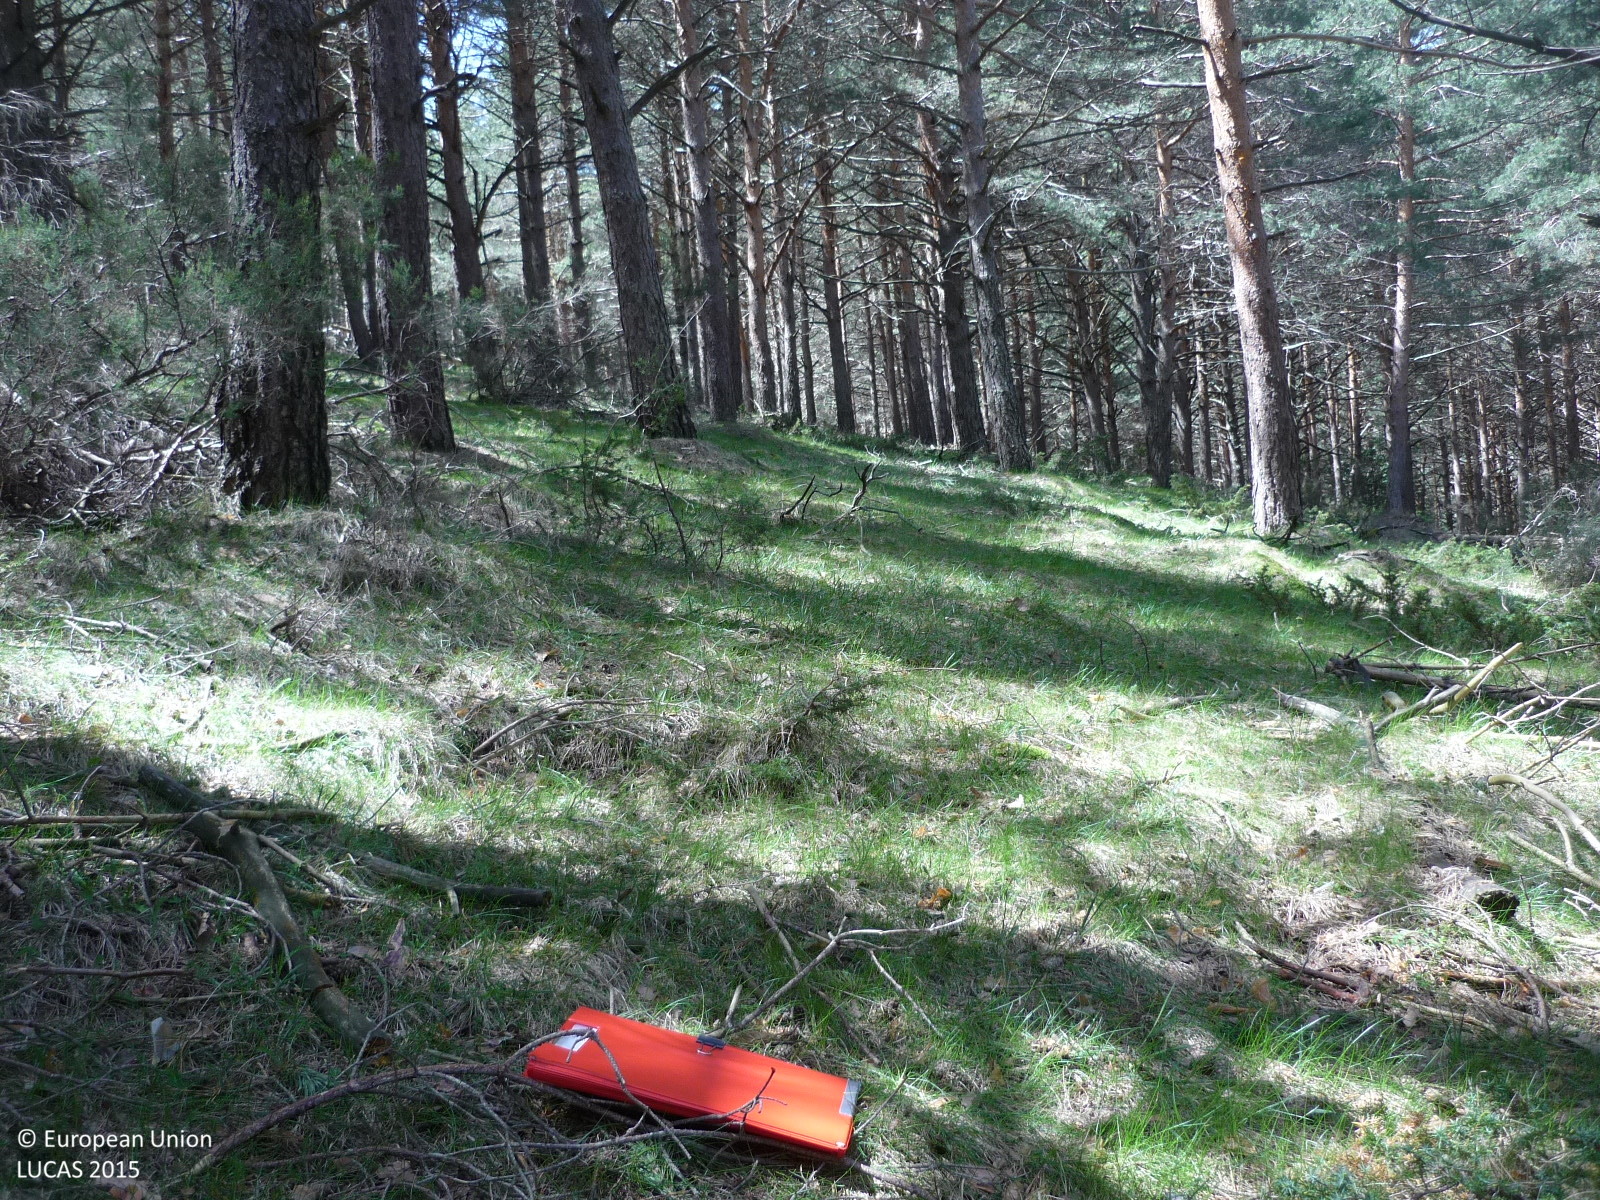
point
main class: Woodland
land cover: Pine dominated coniferous woodland
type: coniferous forest of the mediterranean region
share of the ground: > 75 %
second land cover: Grassland without tree/shrub cover
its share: > 75 %
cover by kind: coniferous forest trees 90 %, herbaceous plants 10 %
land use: Forestry
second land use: Agriculture (excluding fallow land and kitchen gardens)
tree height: > 5 m
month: April
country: ES
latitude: 41.1265
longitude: -3.6122
